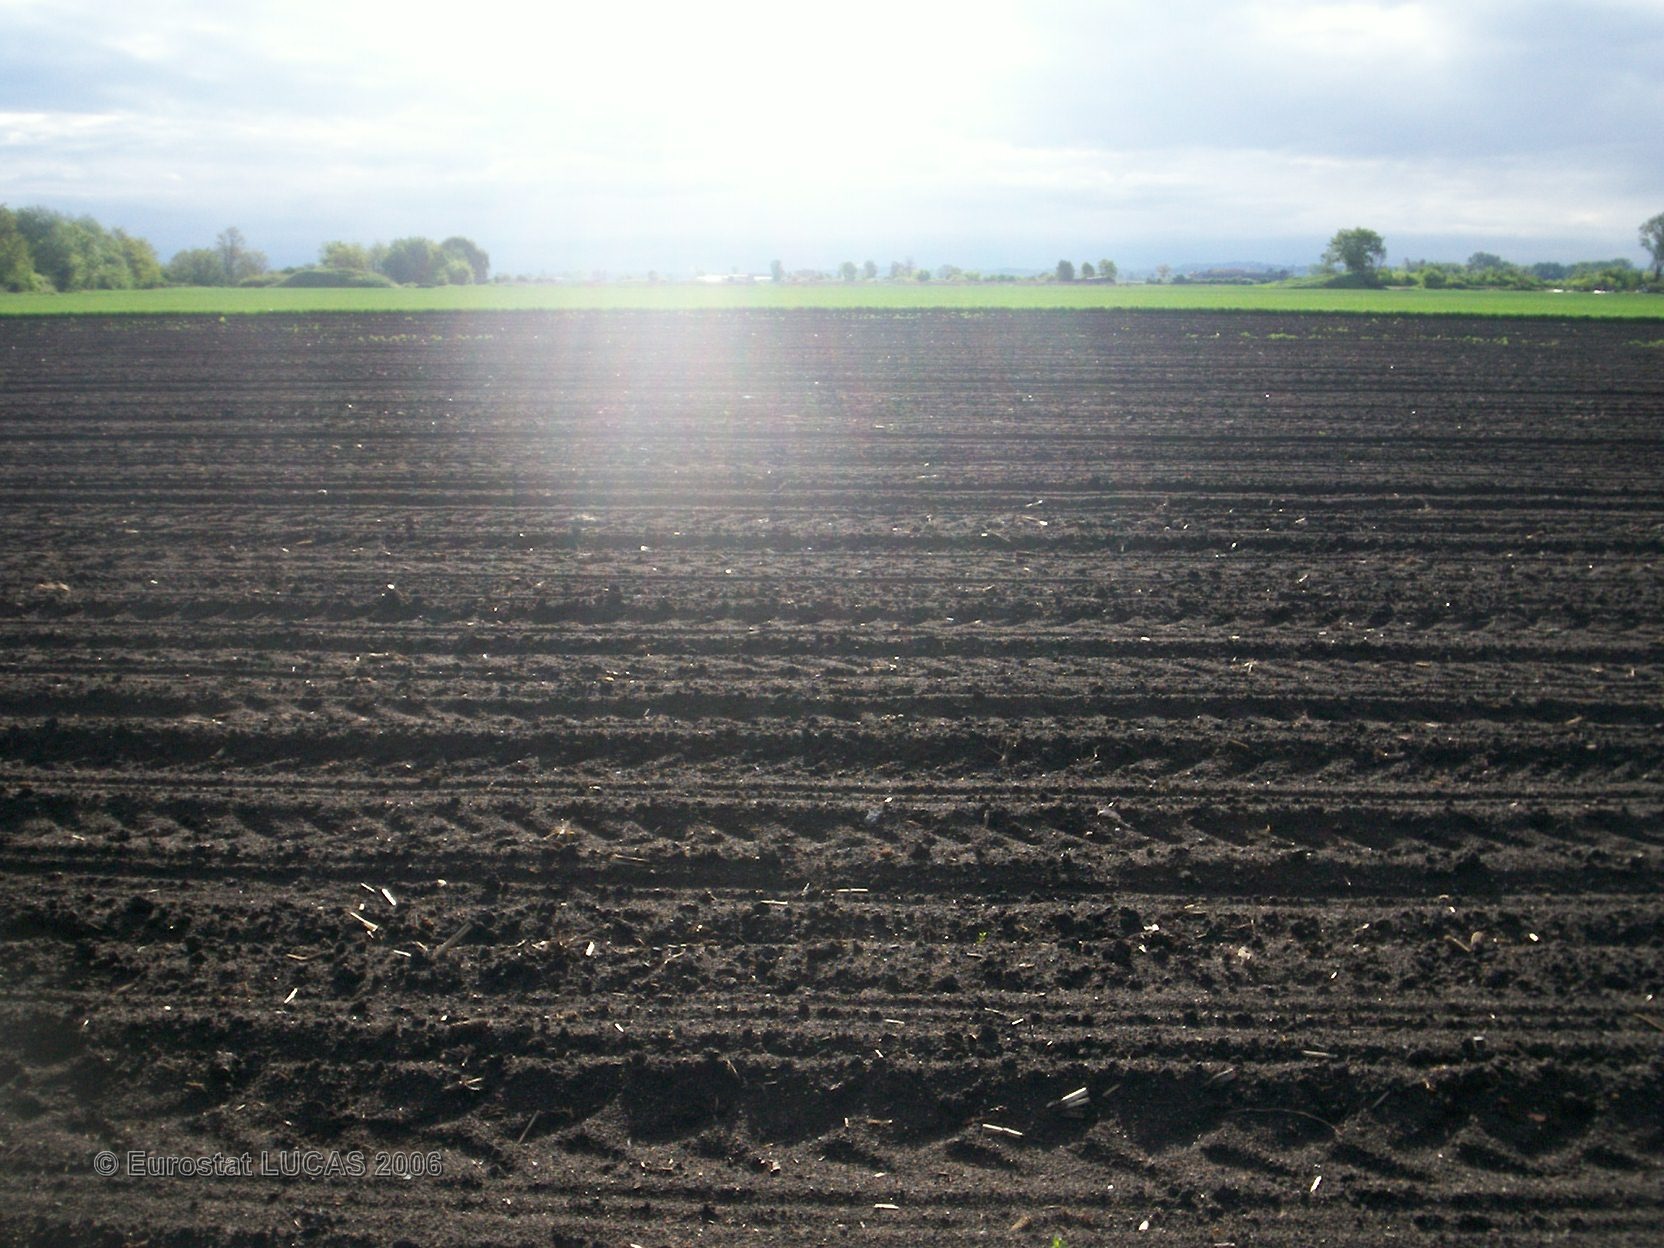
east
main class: Cropland
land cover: Maize
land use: Agriculture (excluding fallow land and kitchen gardens)
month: May
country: FR
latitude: 45.8252
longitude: 3.1648
